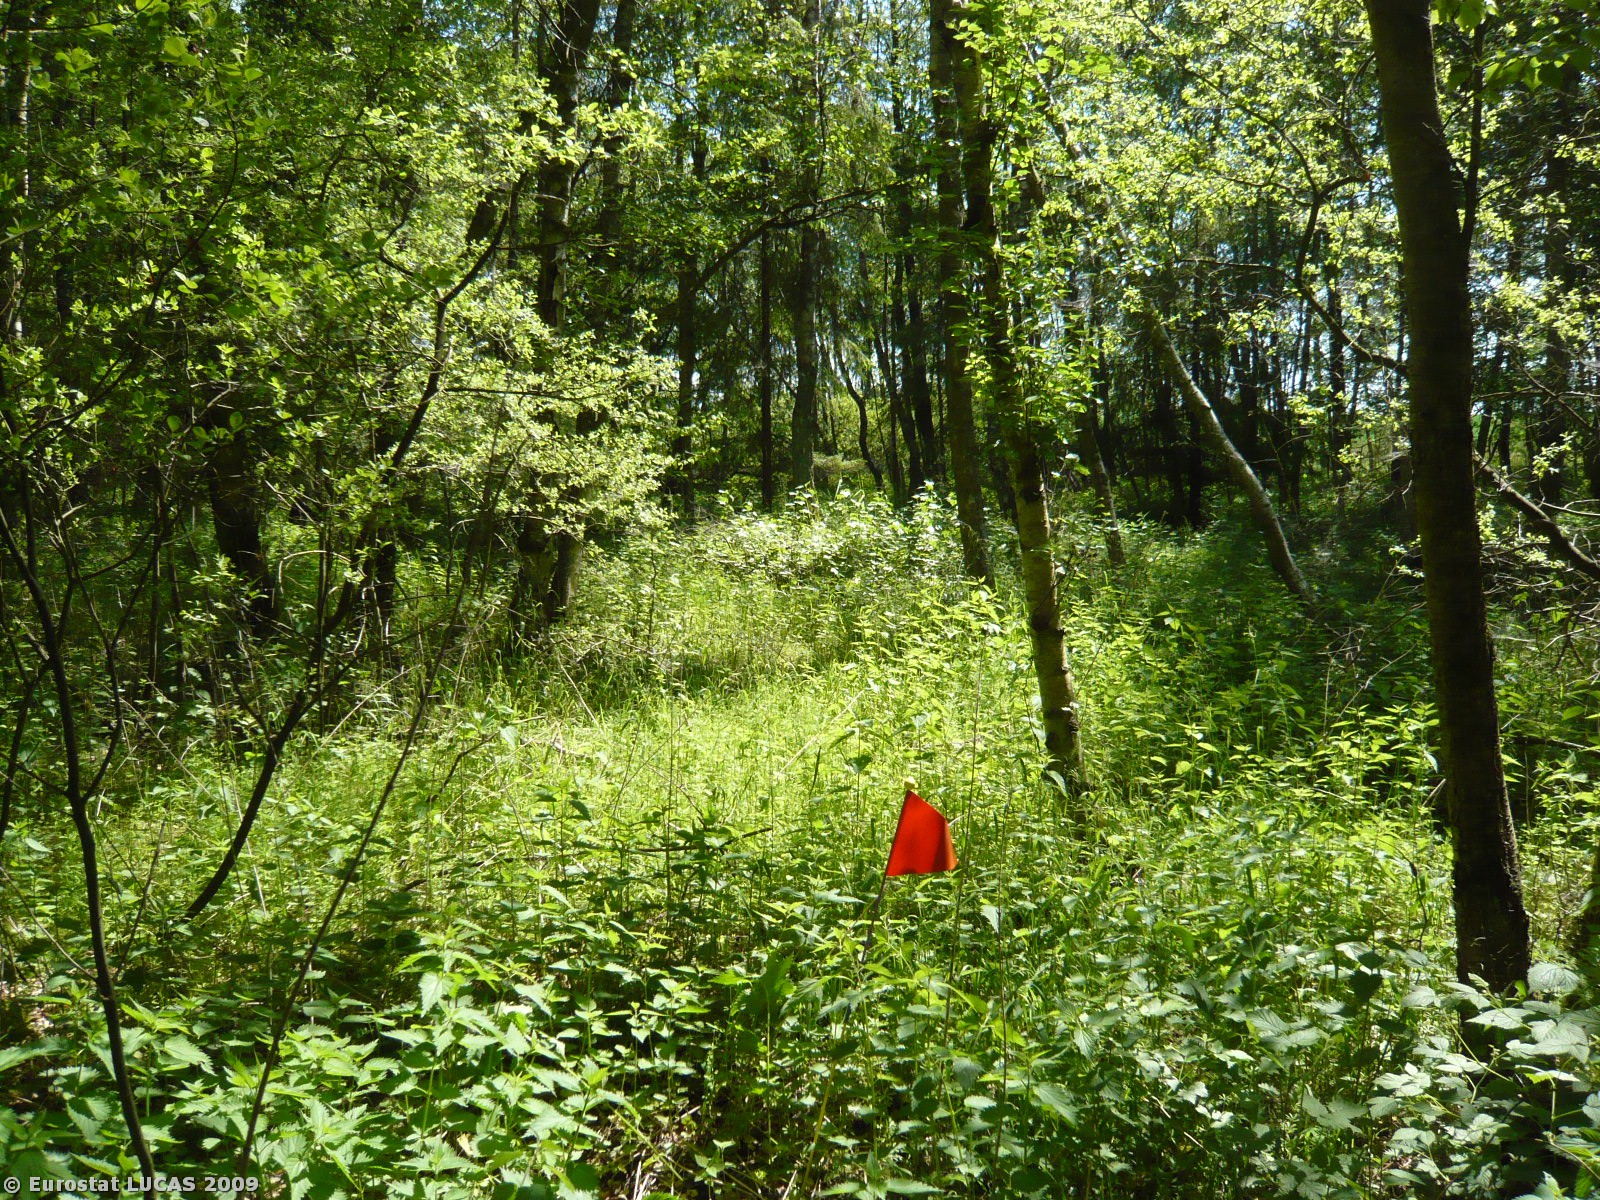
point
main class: Woodland
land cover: Broadleaved woodland
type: non-riverine alder, birch or aspen forest
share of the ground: > 75 %
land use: Forestry
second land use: Amenities, museums, leisure
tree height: > 5 m
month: May
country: DK
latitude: 55.3124
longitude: 11.7790
